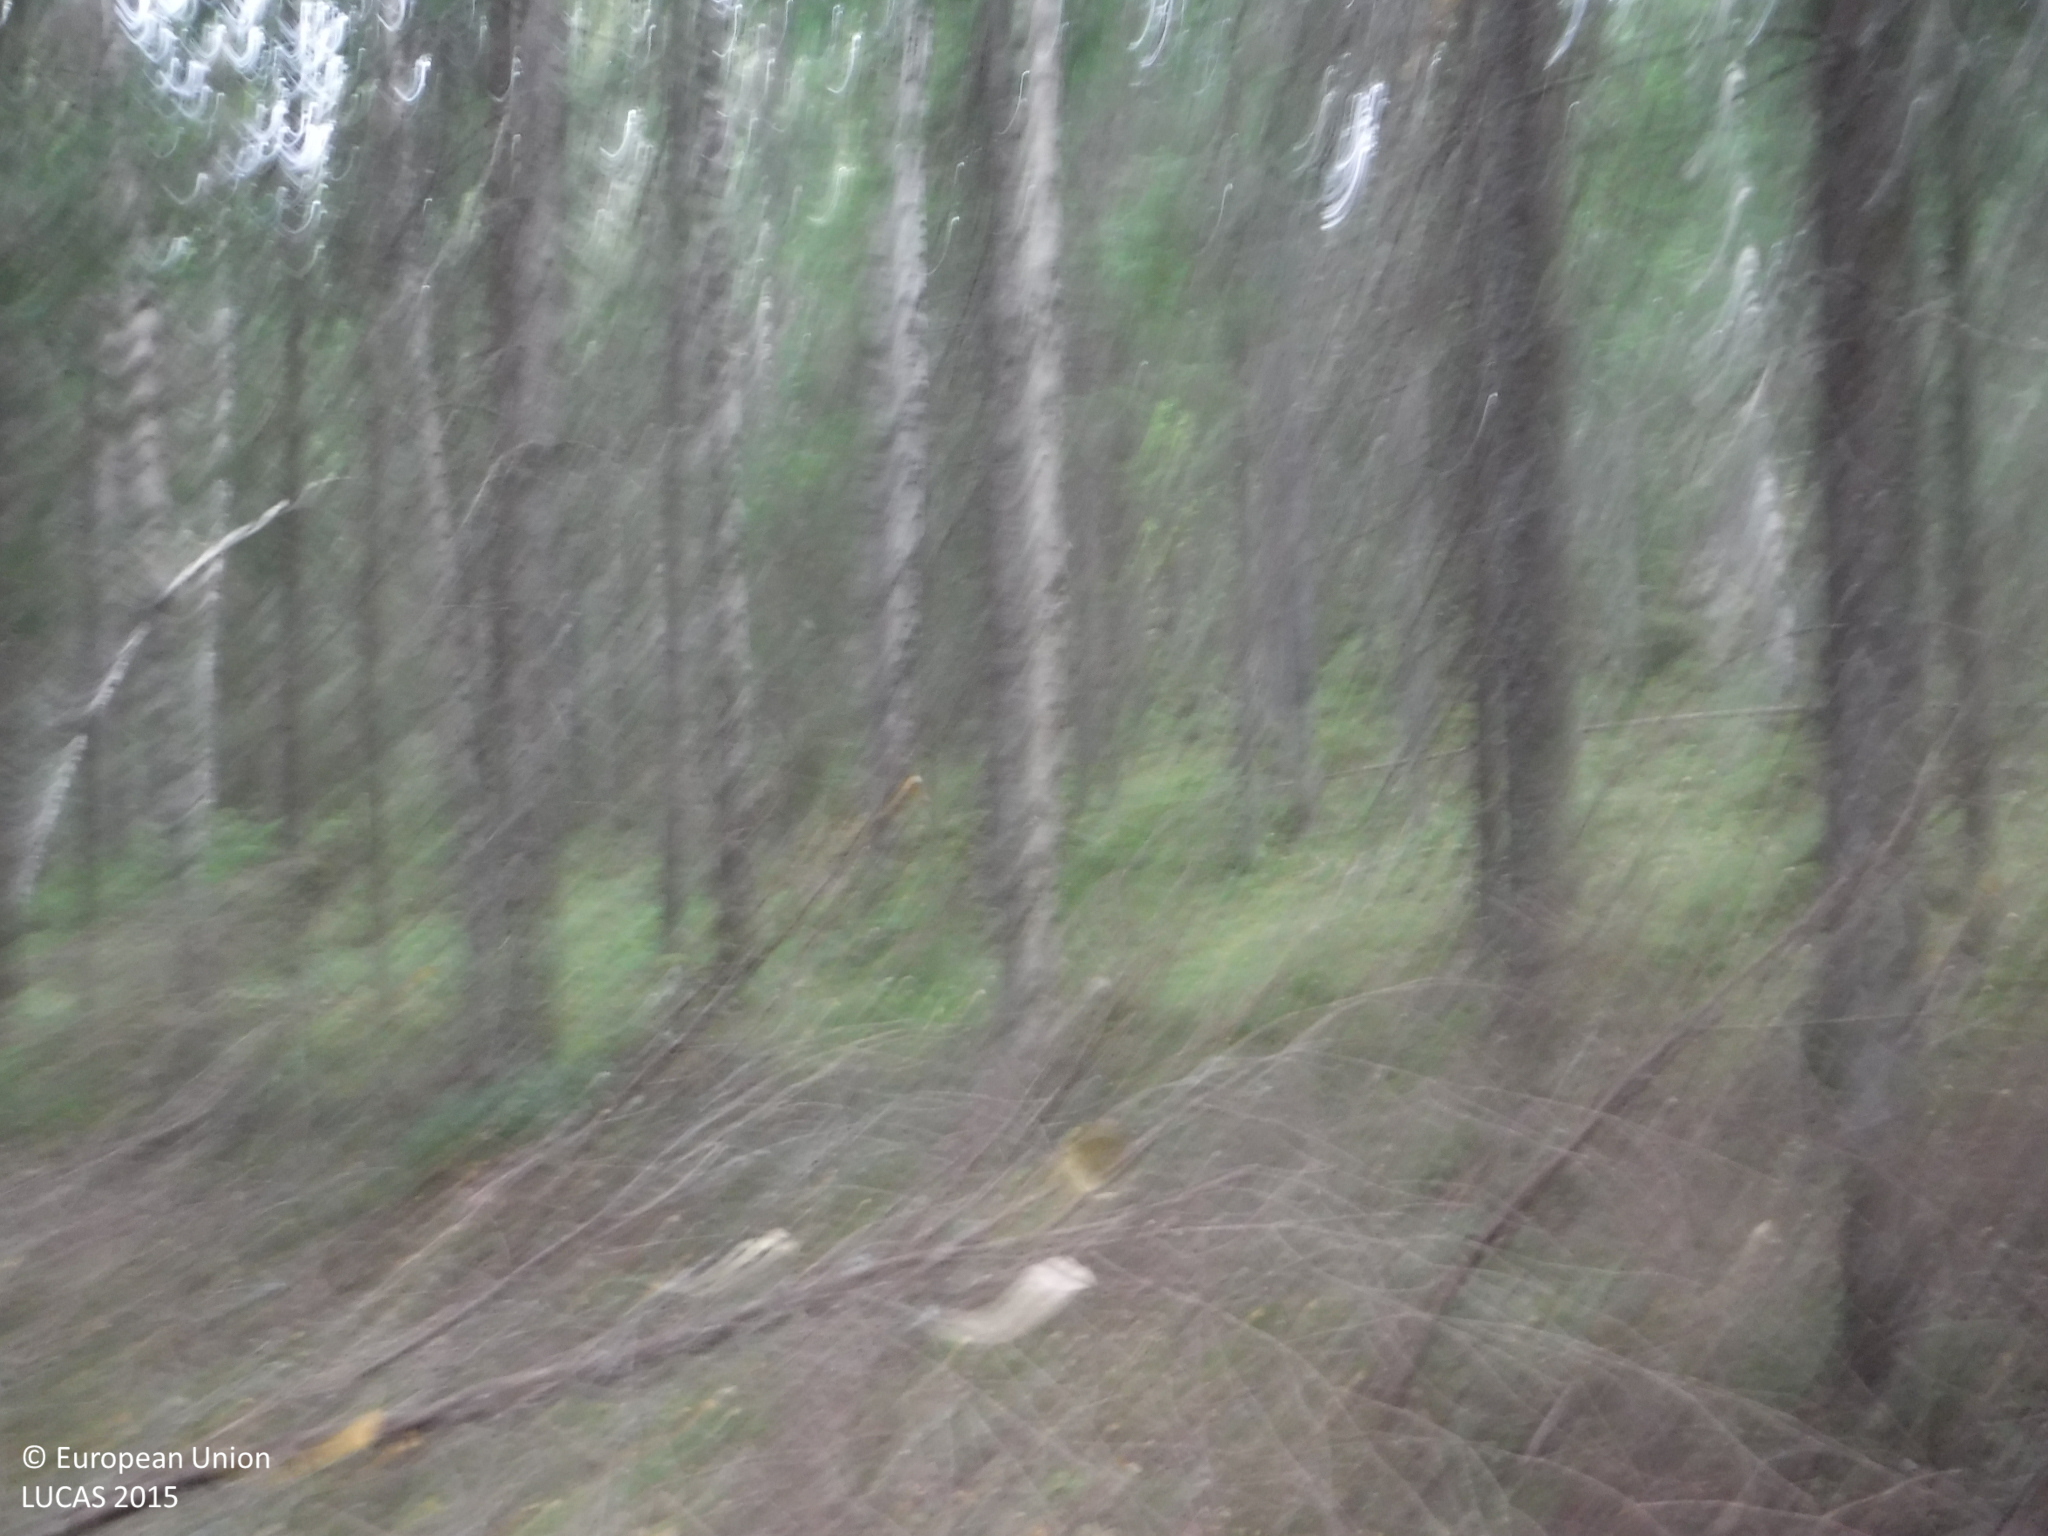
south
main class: Woodland
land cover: Spruce dominated mixed woodland
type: boreal forest
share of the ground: 50 - 75 %
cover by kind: coniferous forest trees 40 %, lichens and mosses 30 %, broadleaved forest trees 20 %, shrubs 10 %
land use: Forestry
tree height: > 5 m
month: August
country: FI
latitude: 61.2768
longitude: 22.9994
